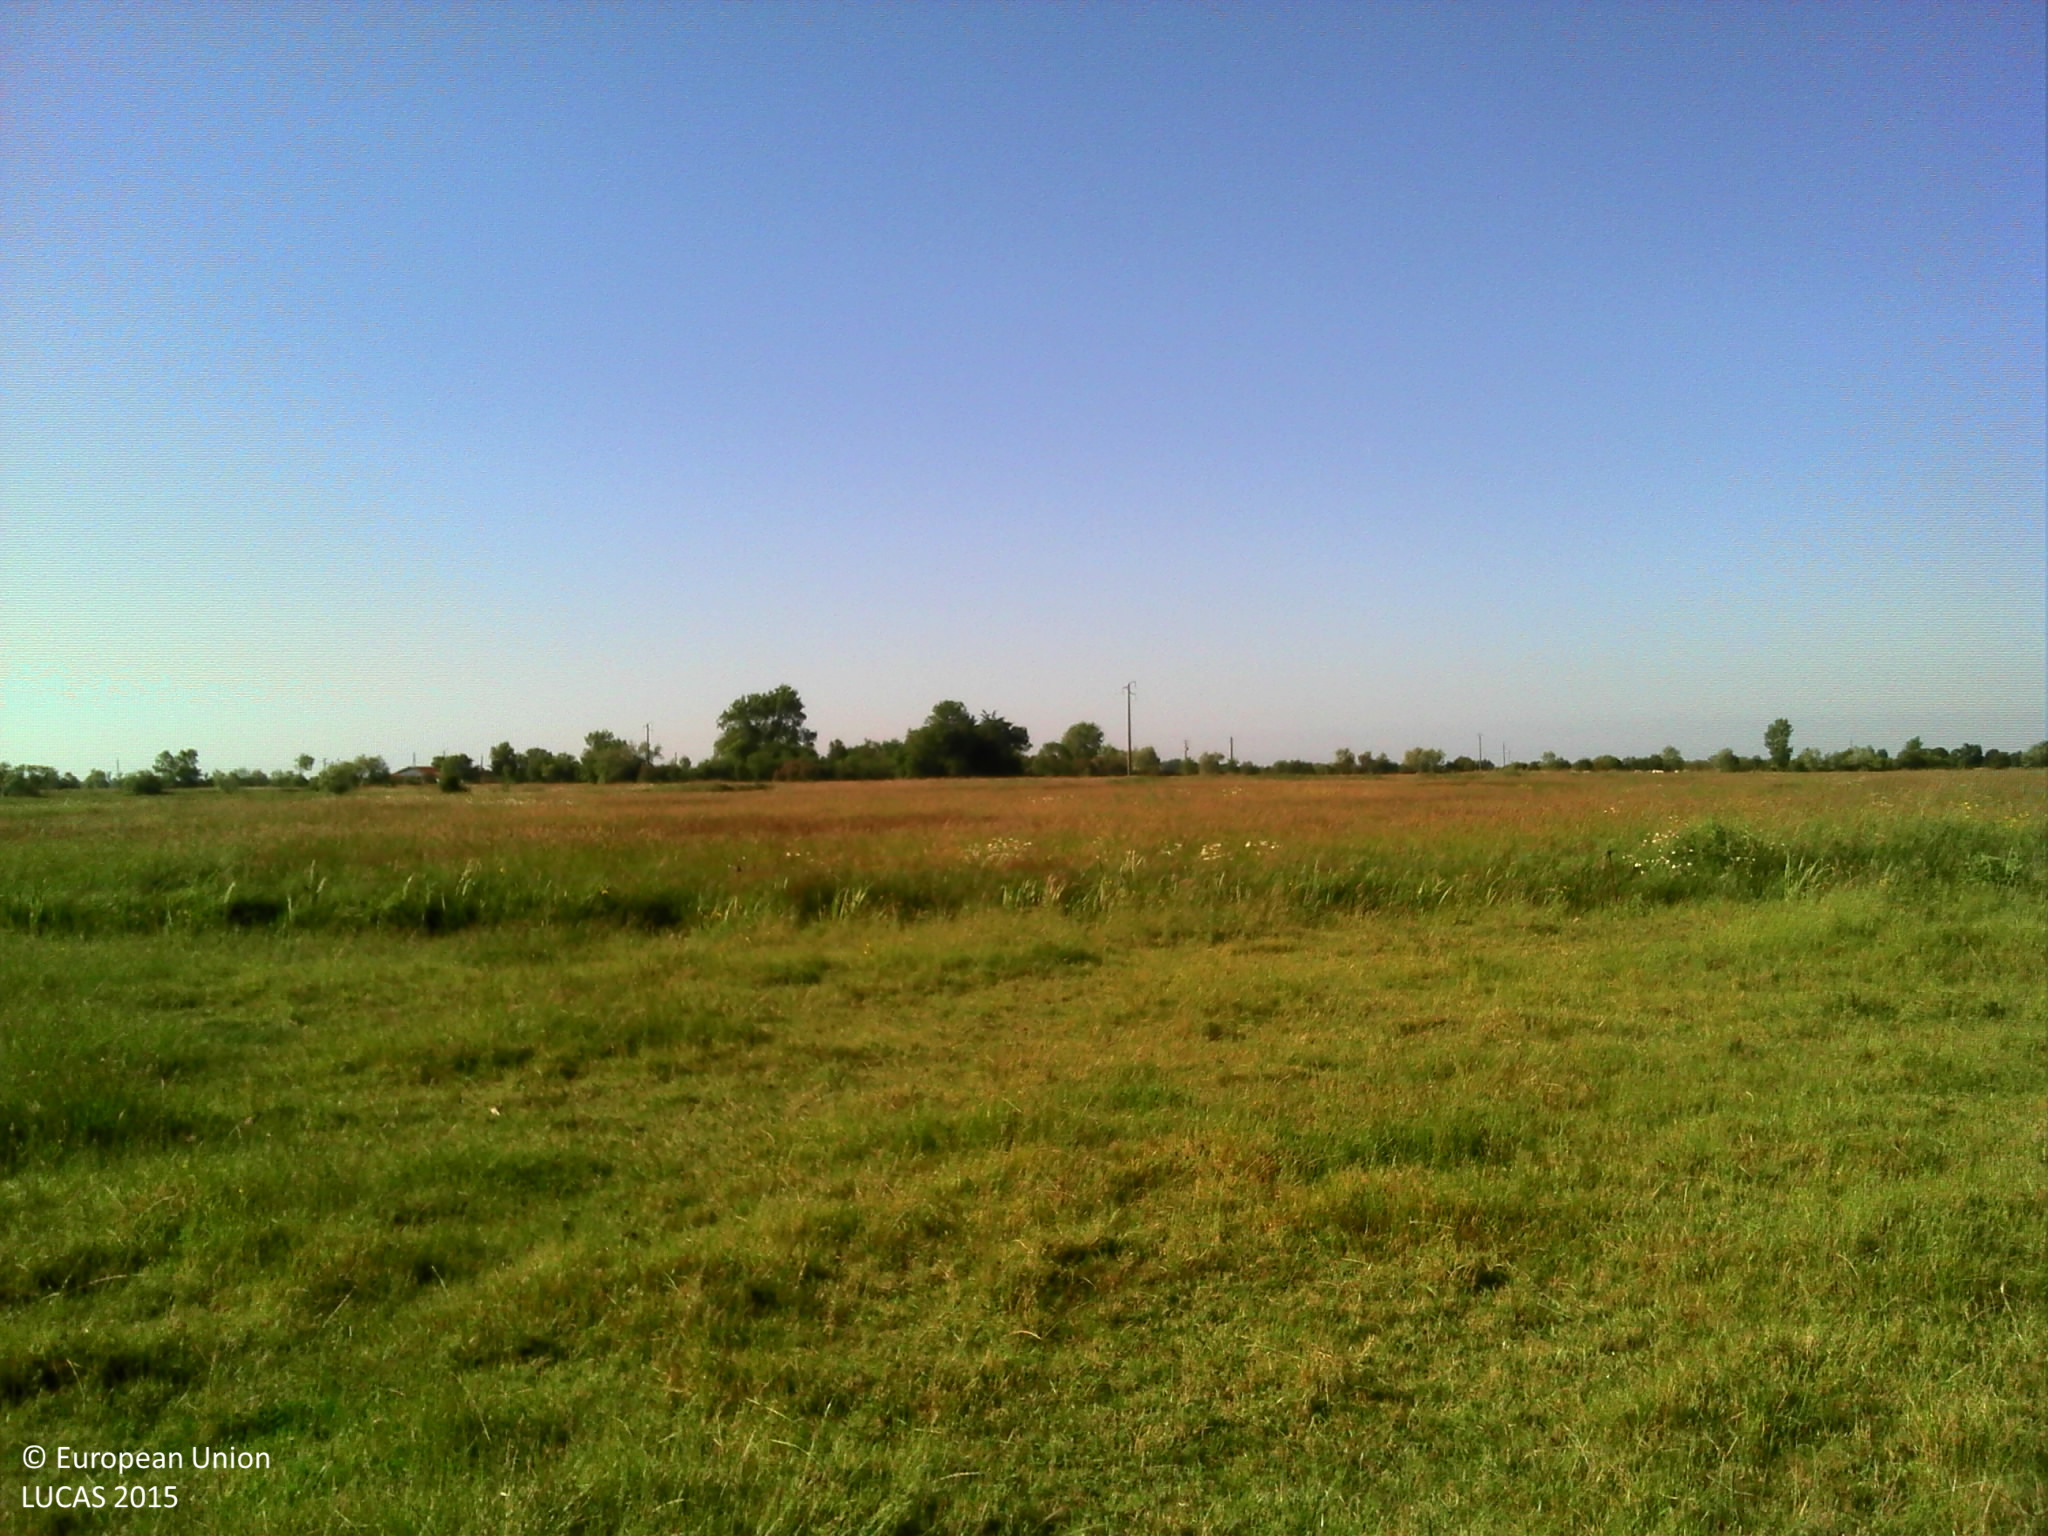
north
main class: Grassland
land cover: Grassland without tree/shrub cover
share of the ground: > 75 %
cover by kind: herbaceous plants 100 %
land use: Agriculture (excluding fallow land and kitchen gardens)
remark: Temporary flooded
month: June
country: FR
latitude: 46.7706
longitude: -1.9487
